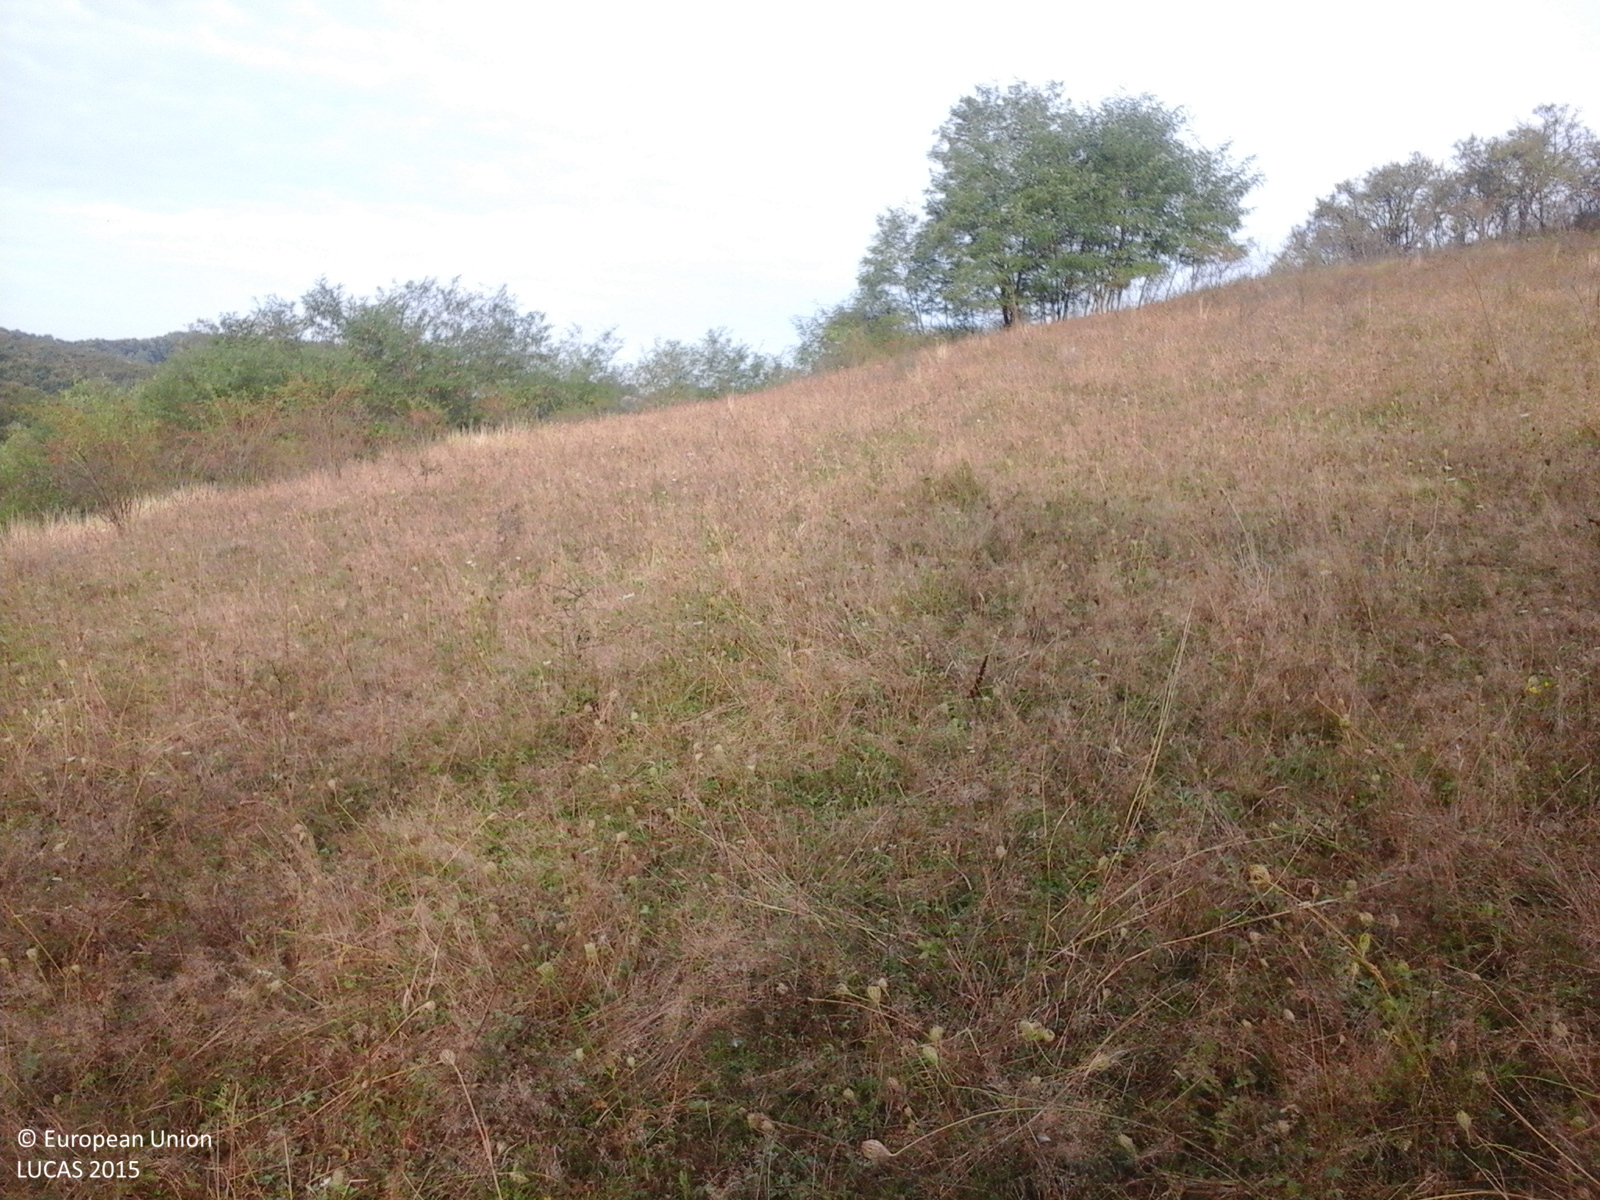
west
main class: Grassland
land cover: Grassland without tree/shrub cover
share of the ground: > 75 %
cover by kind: herbaceous plants 100 %
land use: Agriculture (excluding fallow land and kitchen gardens)
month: September
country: RO
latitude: 47.1565
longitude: 23.4585
